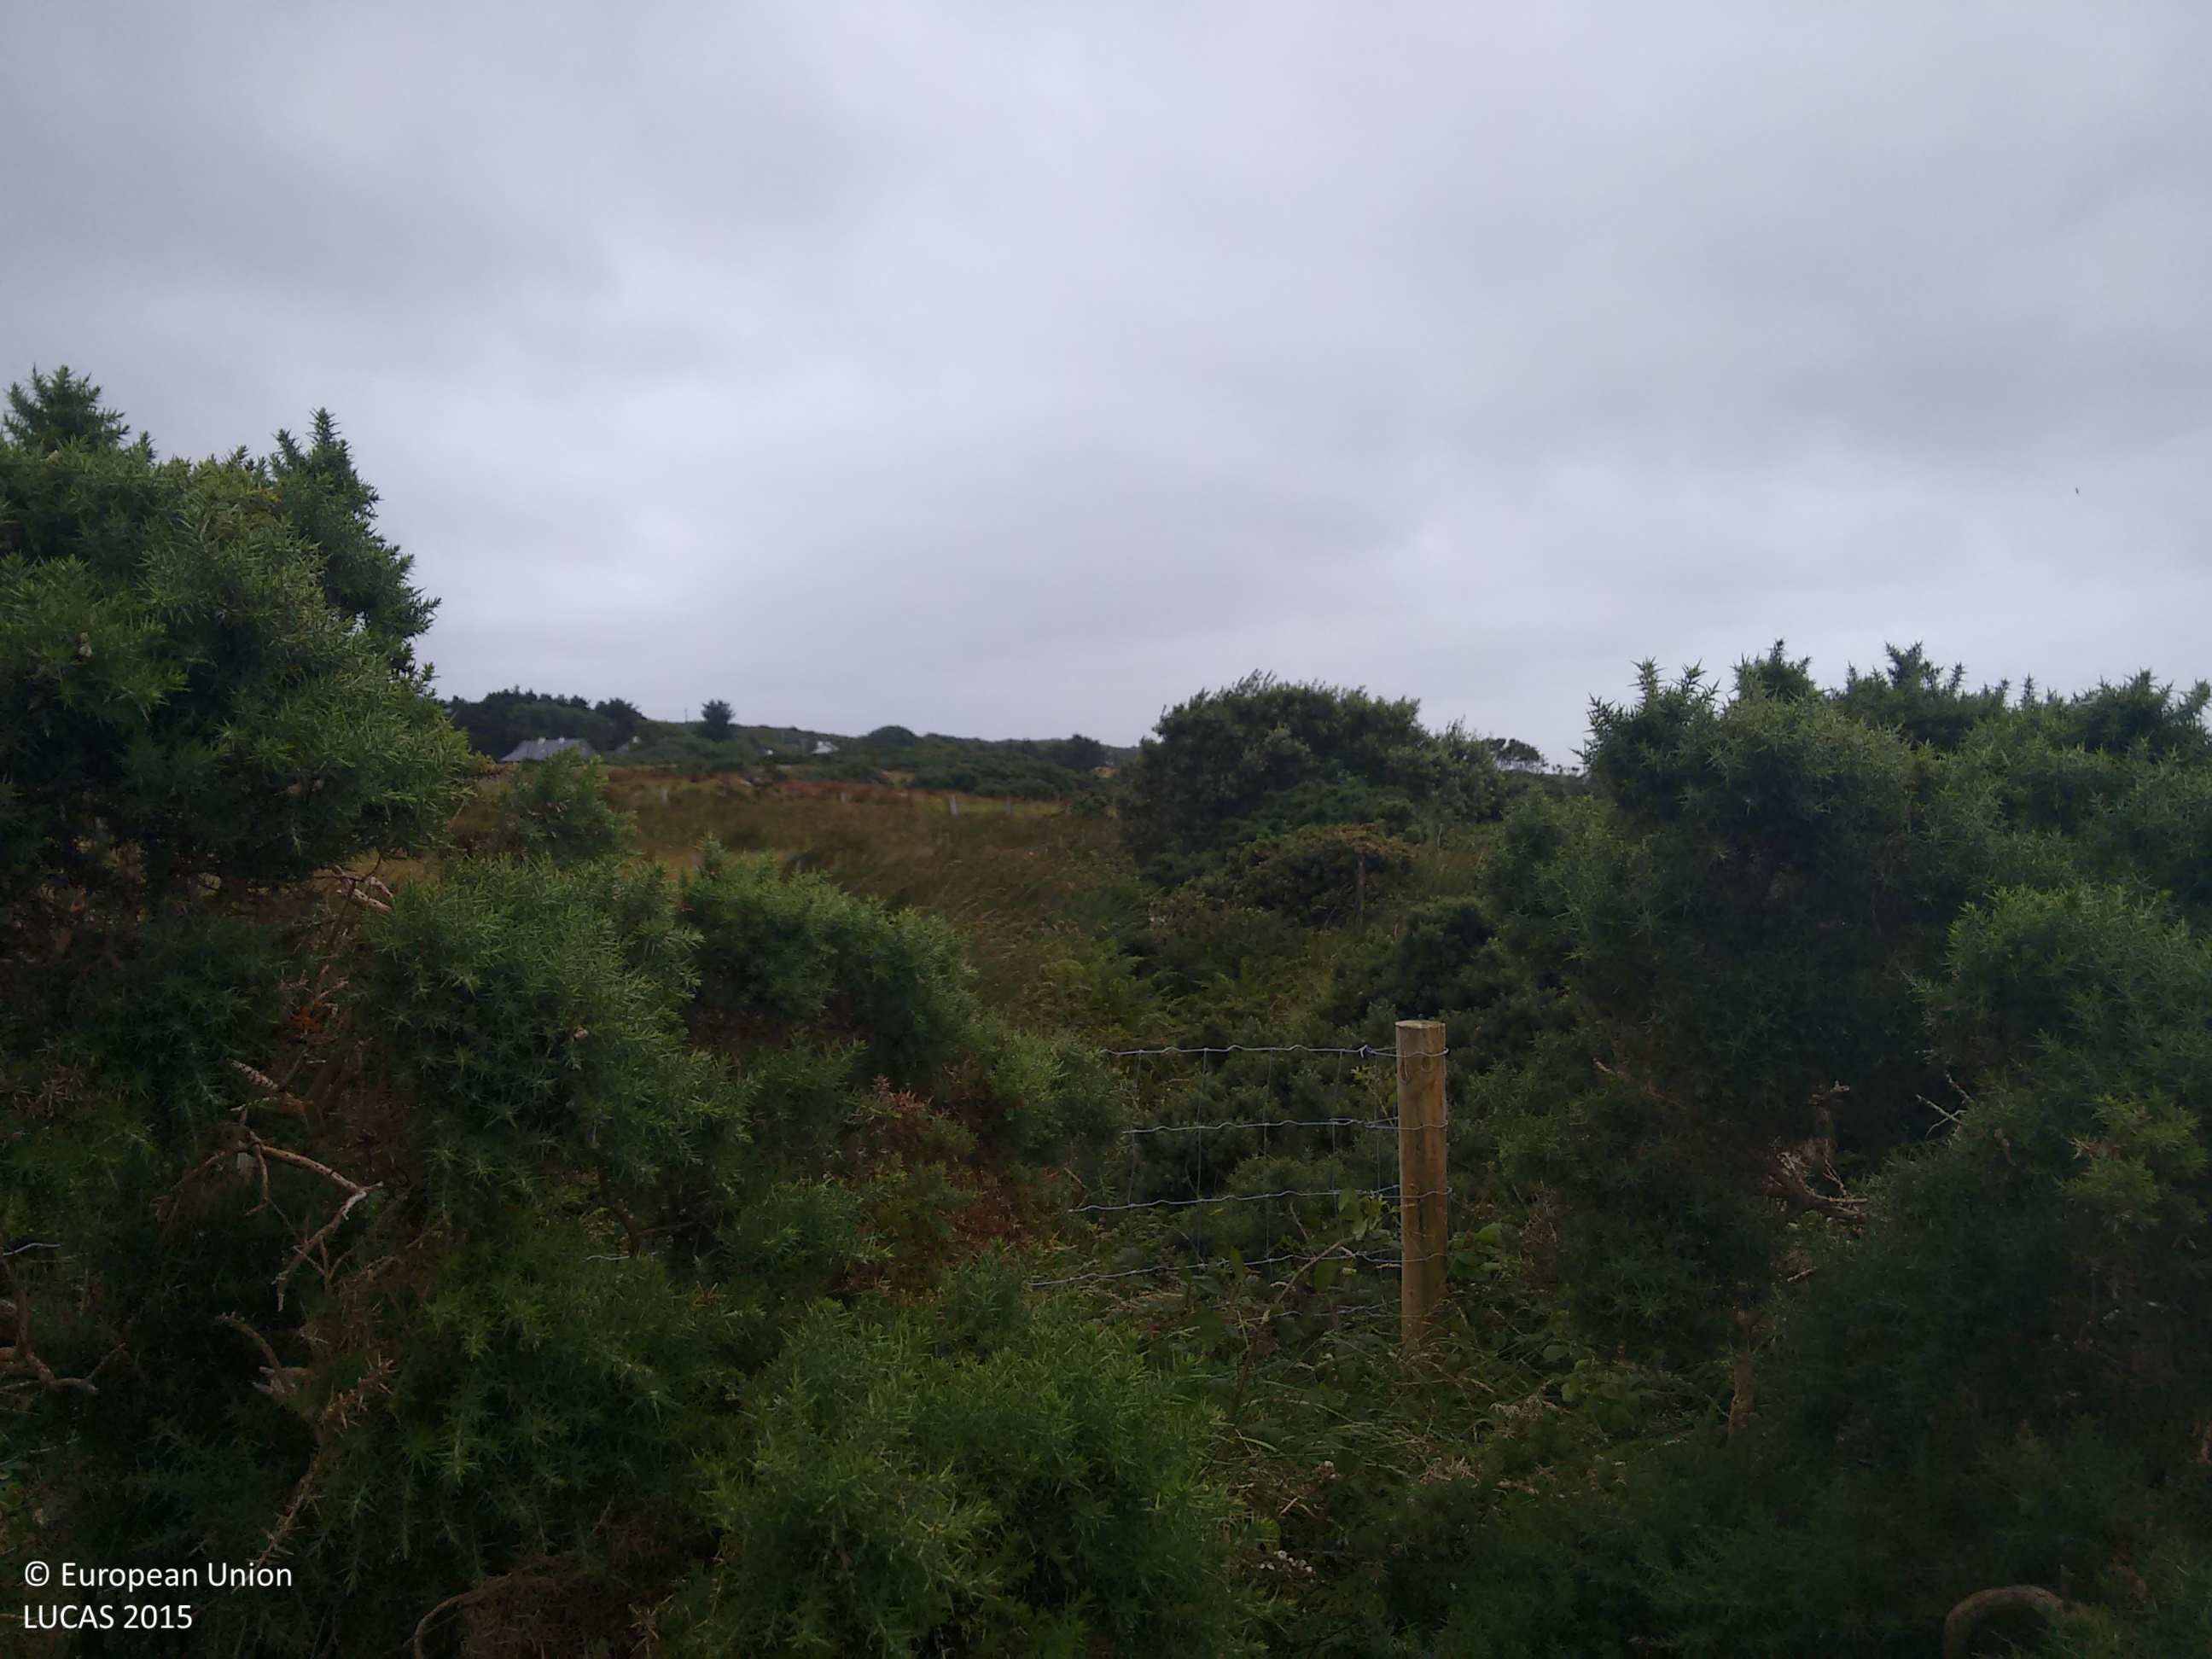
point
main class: Grassland
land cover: Grassland without tree/shrub cover
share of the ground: > 75 %
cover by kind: herbaceous plants 90 %, unconsolidated bare surface 10 %
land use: Agriculture (excluding fallow land and kitchen gardens)
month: August
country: IE
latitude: 53.6005
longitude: -10.0043
